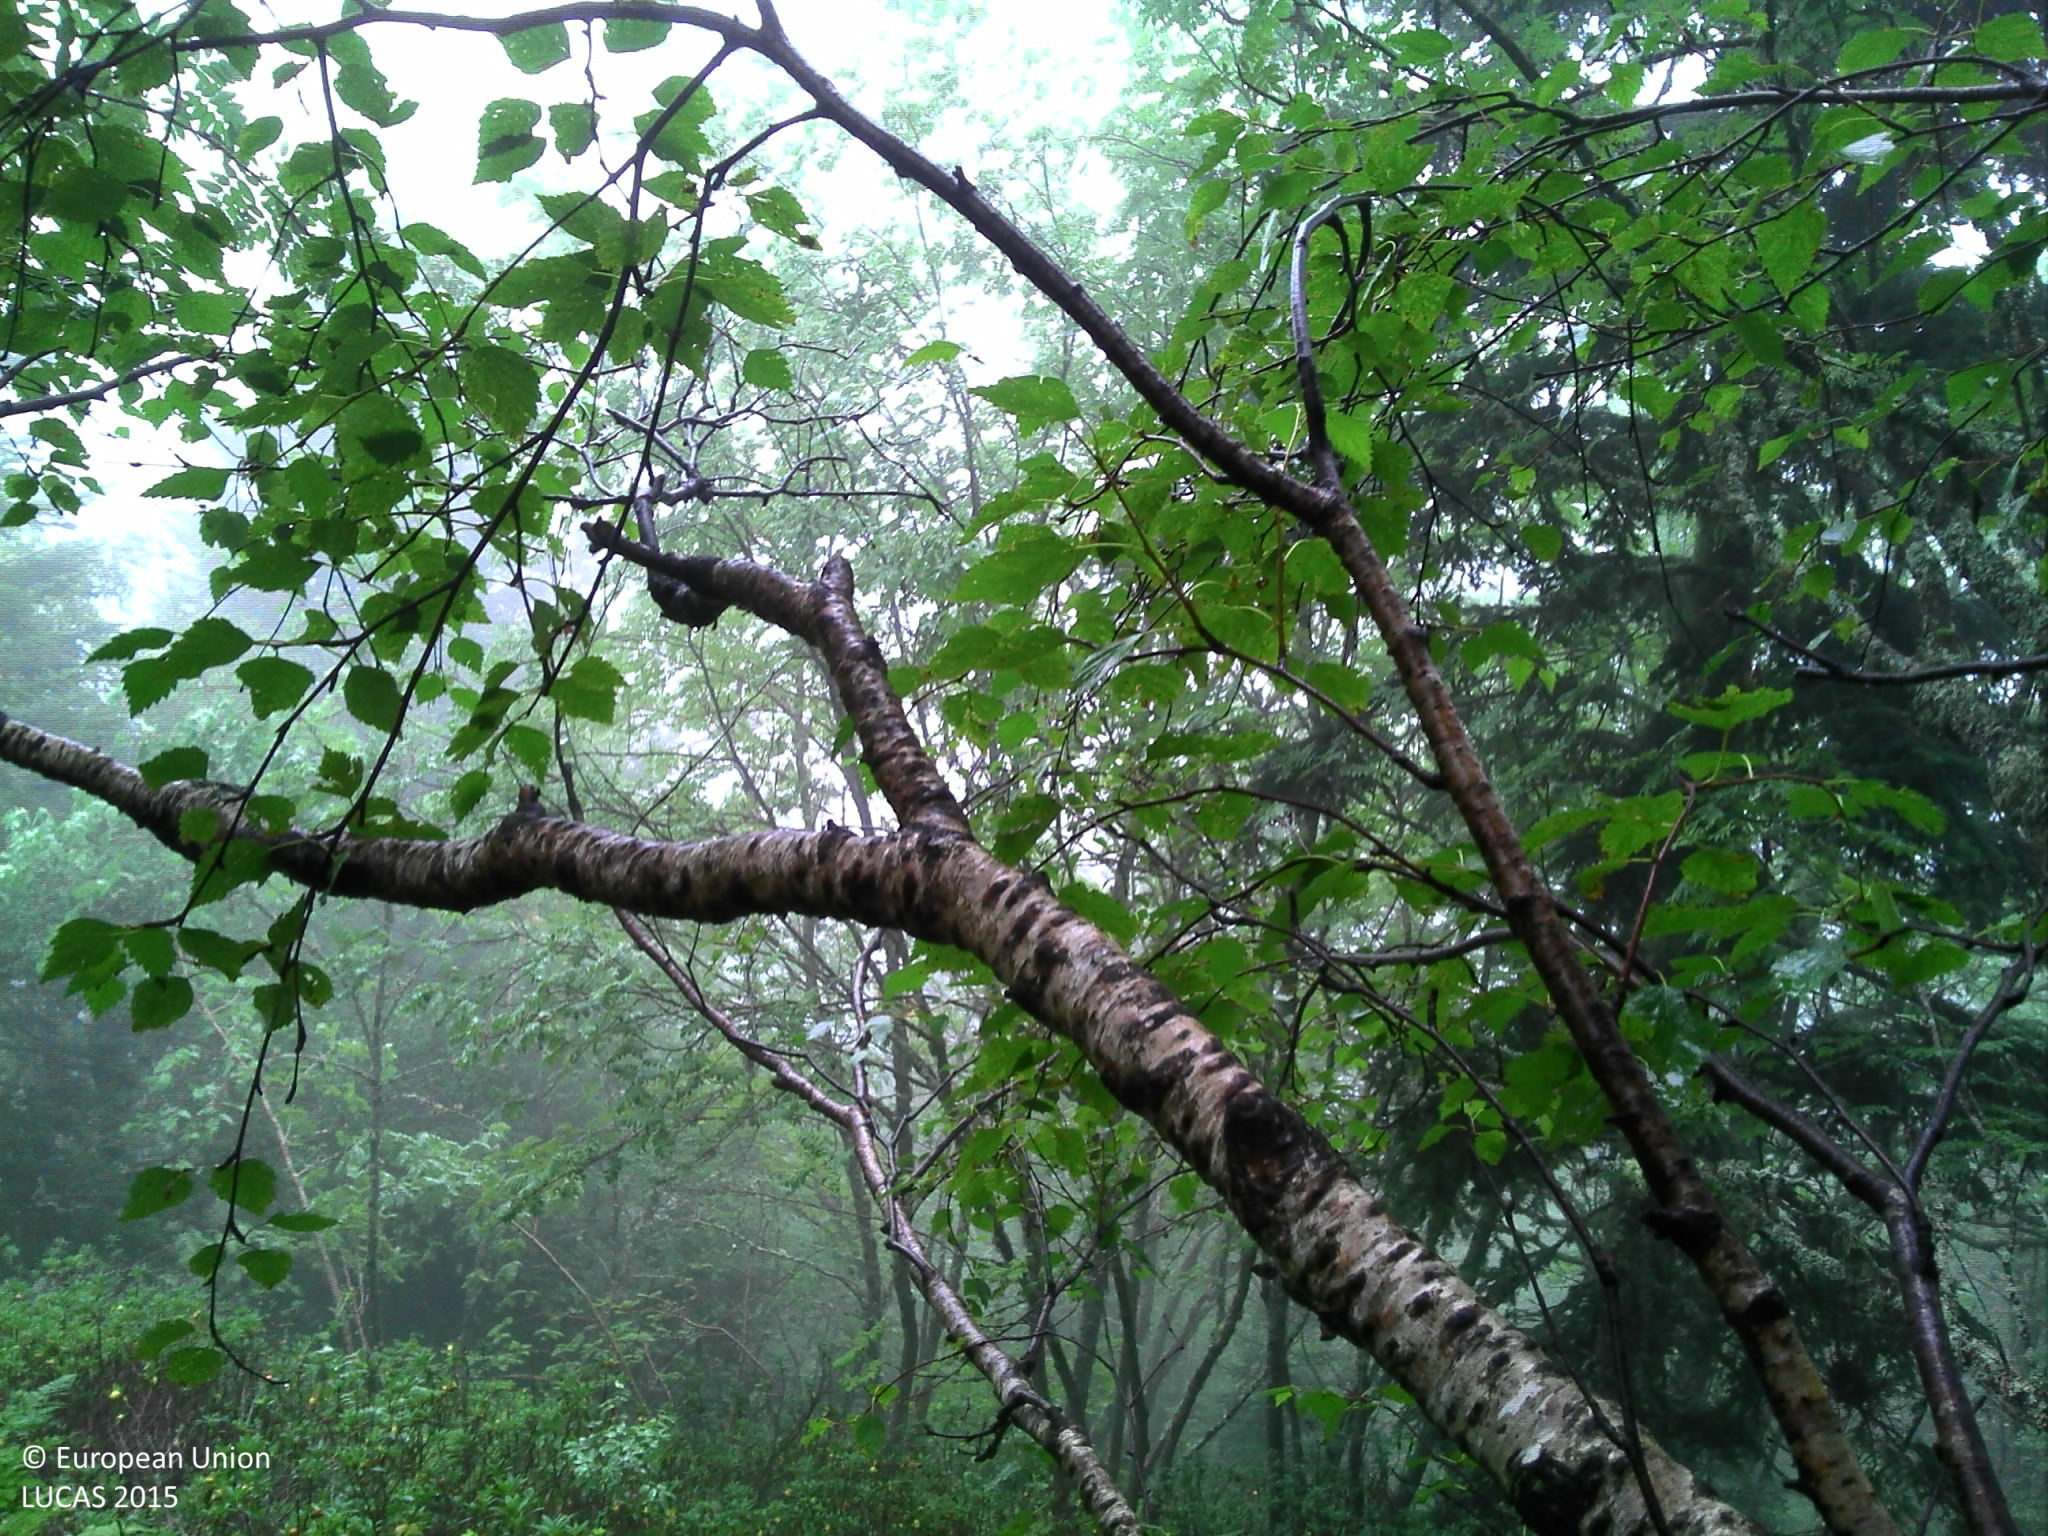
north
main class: Woodland
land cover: Spruce dominated mixed woodland
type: mountainous beech forest
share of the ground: > 75 %
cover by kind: broadleaved forest trees 45 %, herbaceous plants 40 %, coniferous forest trees 15 %
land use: Semi-natural and natural areas not in use
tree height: > 5 m
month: August
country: FR
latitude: 42.7295
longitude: 1.6913
